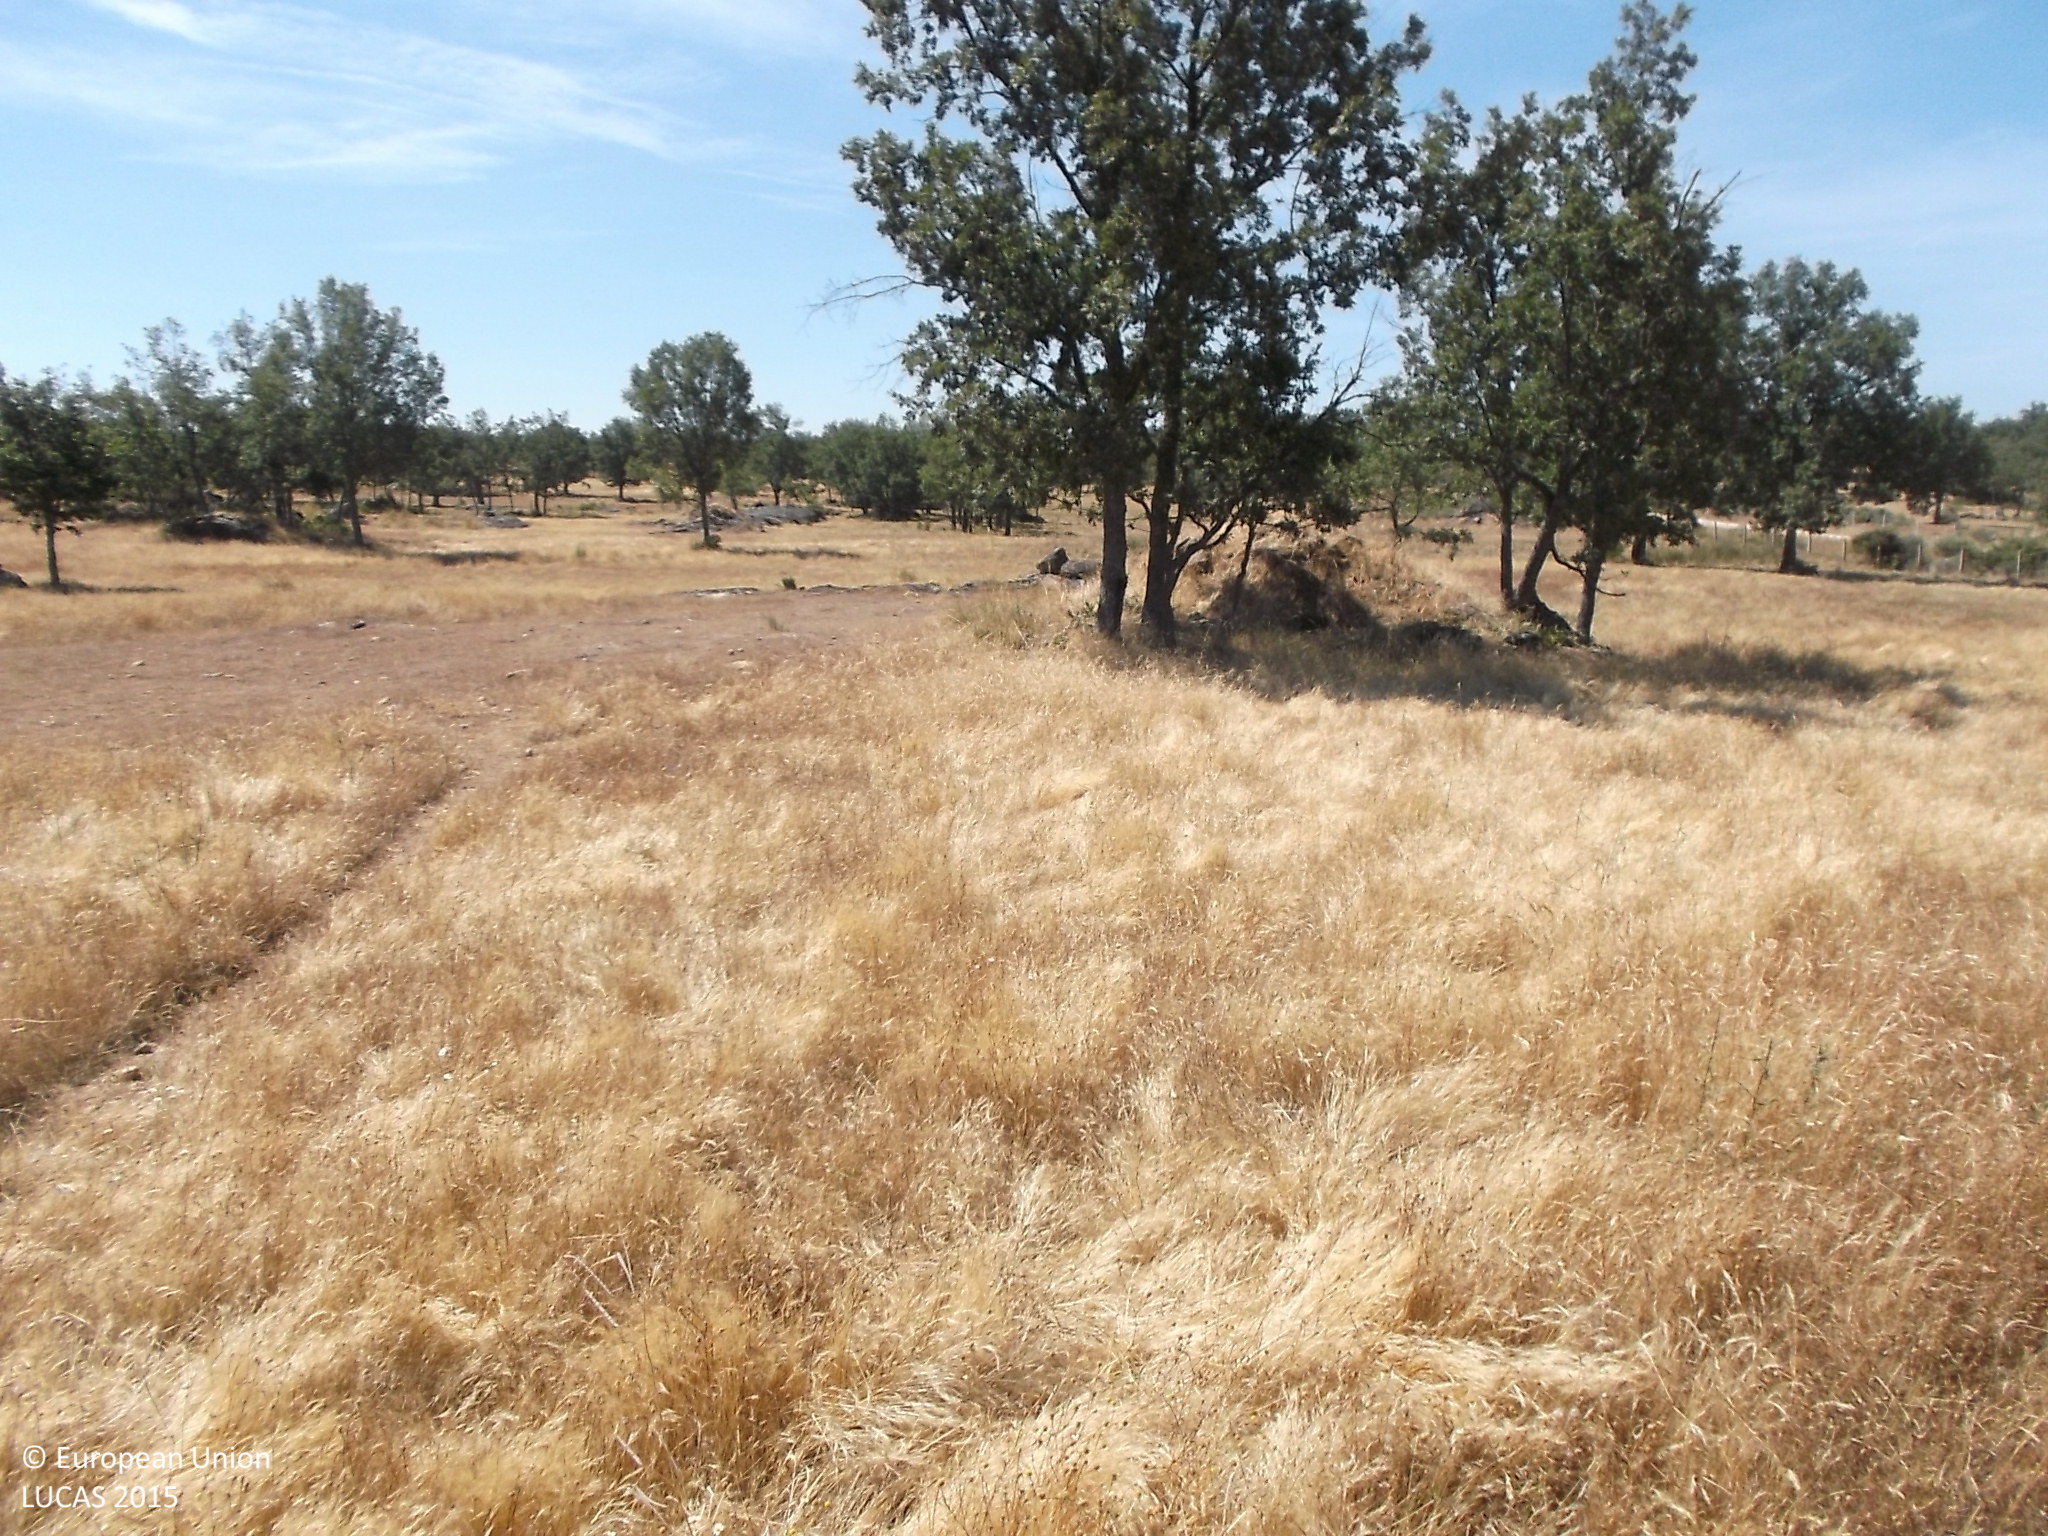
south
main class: Grassland
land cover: Grassland without tree/shrub cover
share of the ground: > 75 %
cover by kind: herbaceous plants 100 %
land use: Agriculture (excluding fallow land and kitchen gardens)
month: July
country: ES
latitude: 41.1851
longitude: -6.4661
